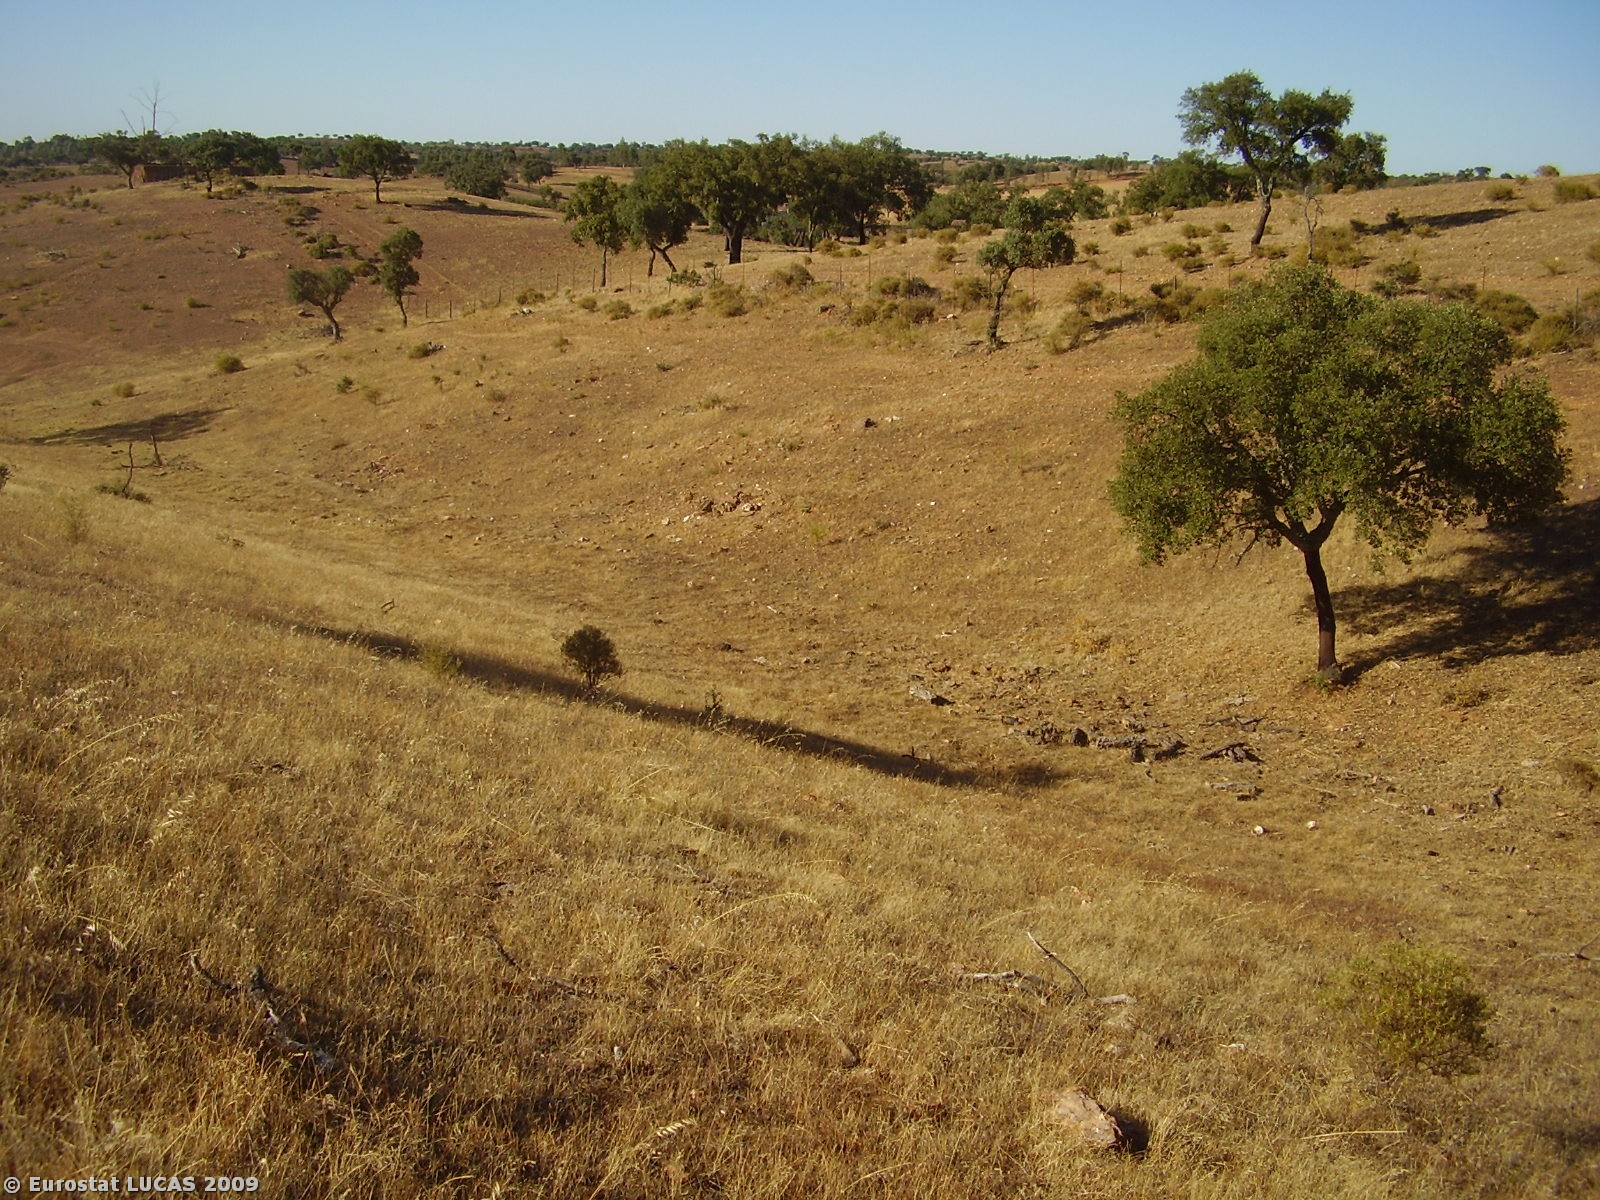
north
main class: Woodland
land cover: Broadleaved woodland
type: broadleaved evergreen forest
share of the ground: 10 - 25 %
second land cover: Grassland with sparse tree/shrub cover
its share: > 75 %
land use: Forestry
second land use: Fallow land
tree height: > 5 m
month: July
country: PT
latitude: 37.8088
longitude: -7.5192
